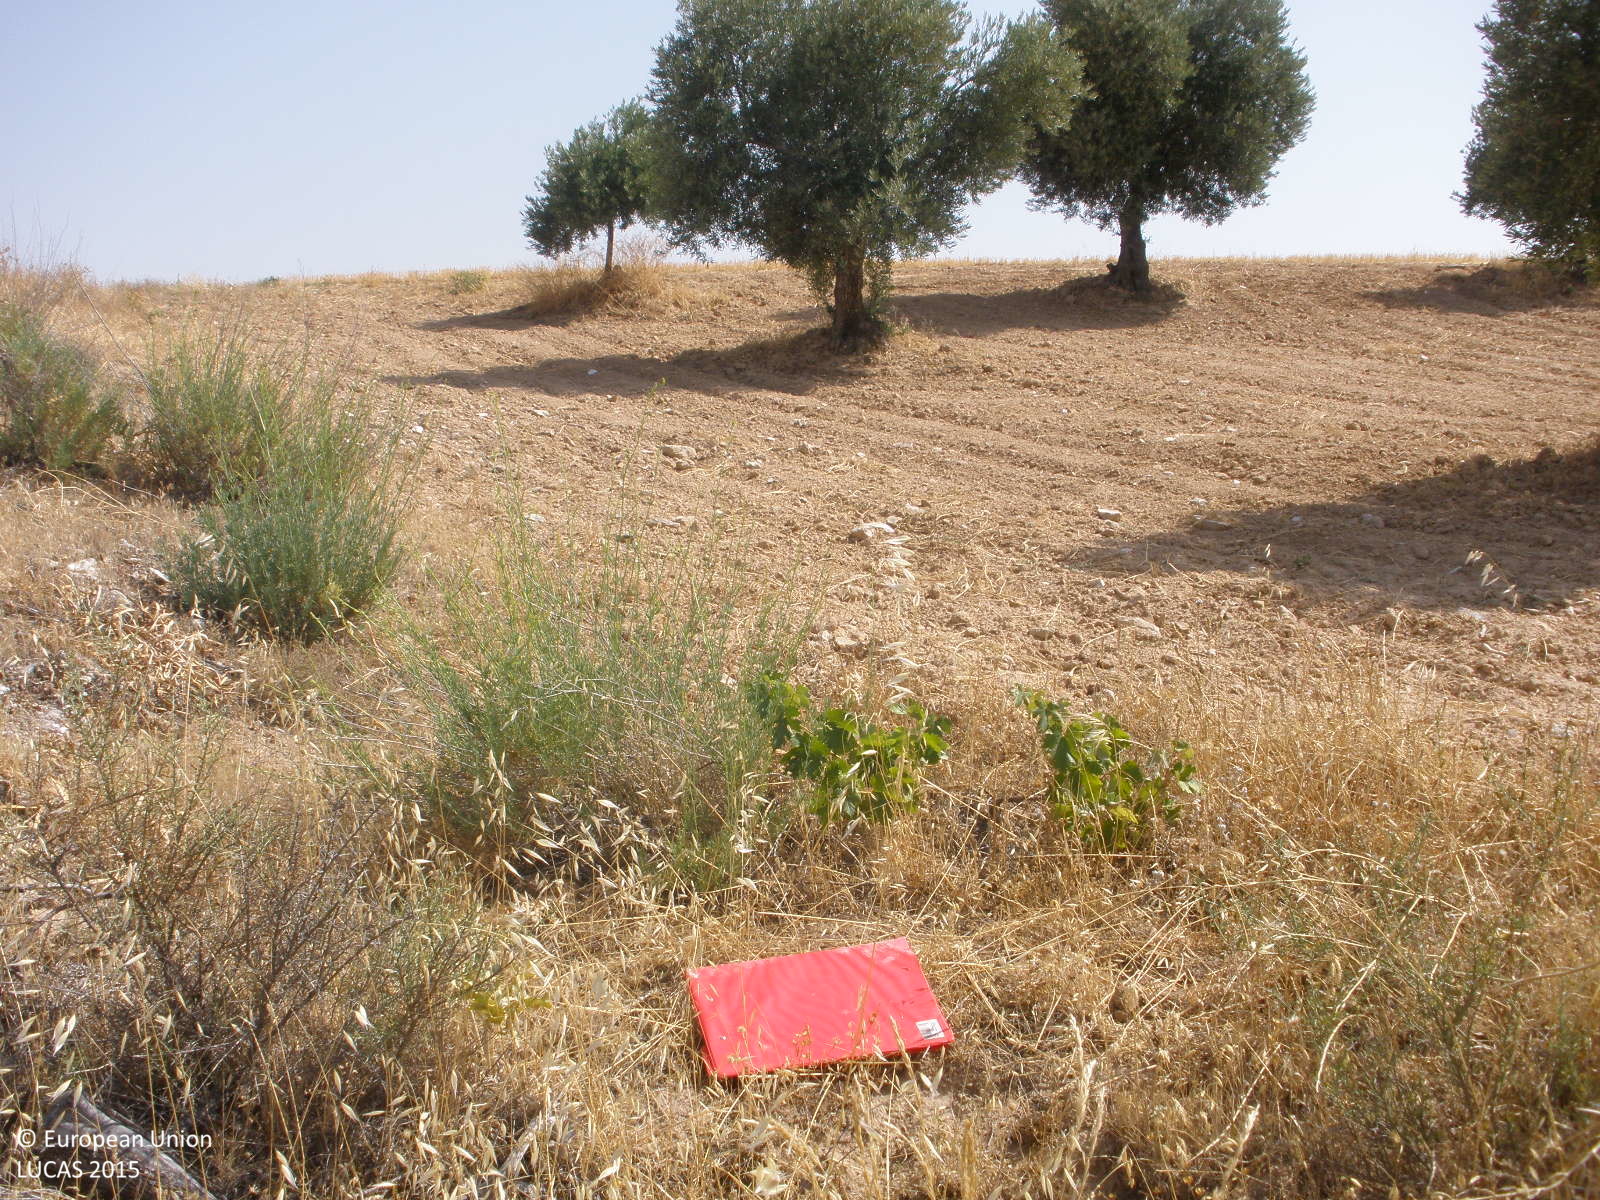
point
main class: Shrubland
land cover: Shrubland without tree cover
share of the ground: 25 - 50 %
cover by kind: herbaceous plants 50 %, shrubs 30 %, consolidated bare surface 20 %
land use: Semi-natural and natural areas not in use
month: July
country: ES
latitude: 40.0278
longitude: -3.3514
